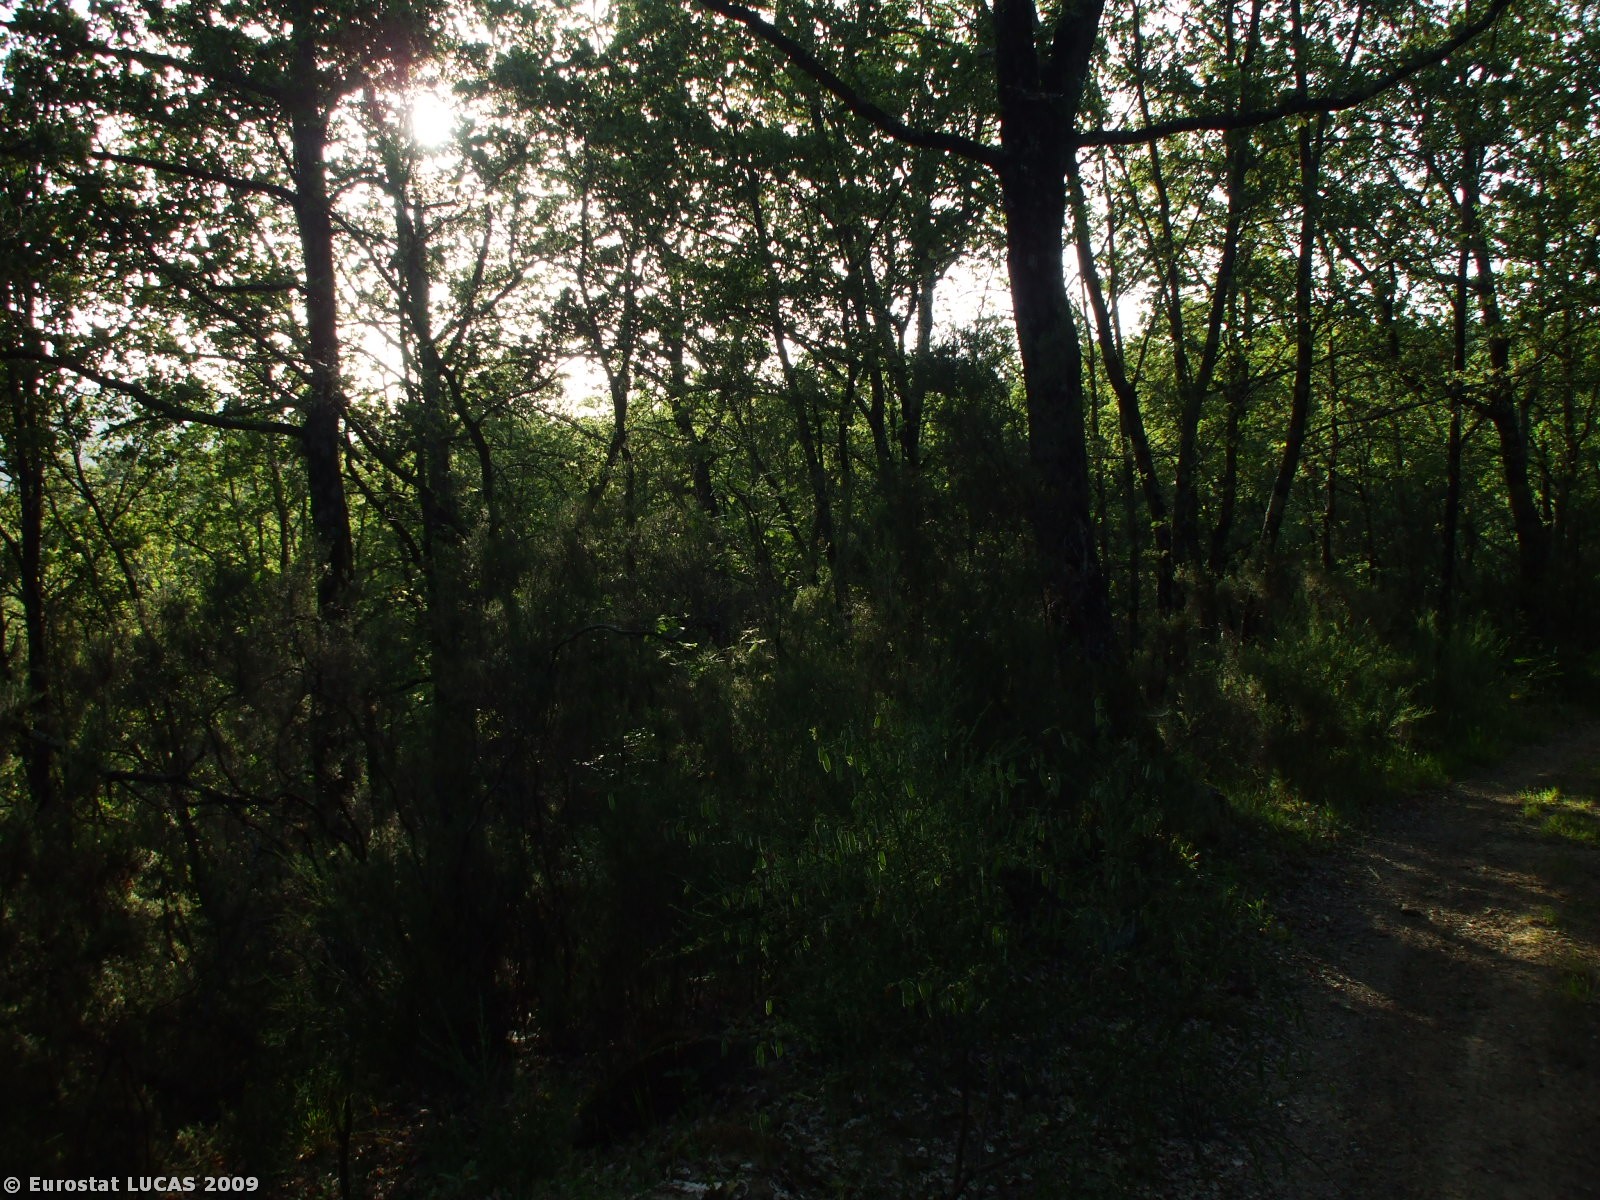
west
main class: Woodland
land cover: Broadleaved woodland
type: thermophilous deciduous forest
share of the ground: > 75 %
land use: Forestry
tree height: > 5 m
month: May
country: IT
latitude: 43.4819
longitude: 12.0592
